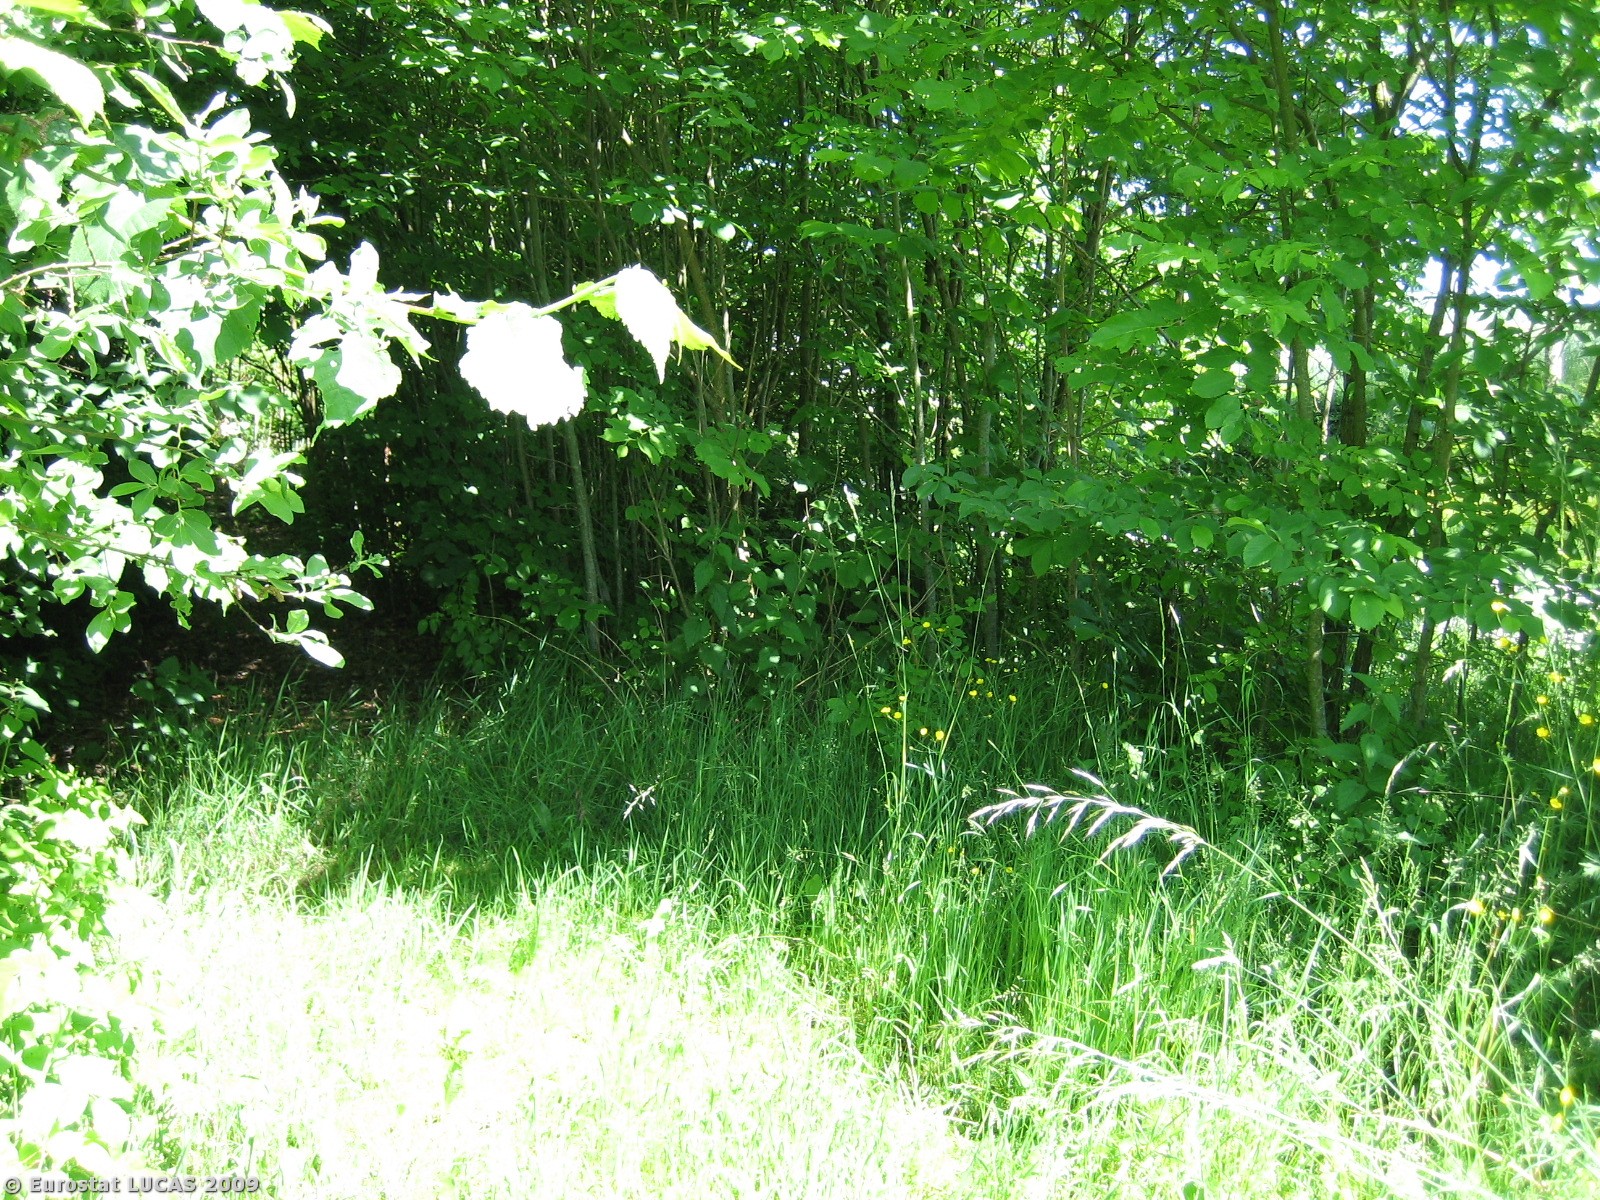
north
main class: Woodland
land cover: Broadleaved woodland
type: mesophytic deciduous forest
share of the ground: > 75 %
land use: Residential
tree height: > 5 m
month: June
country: DK
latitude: 55.9540
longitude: 9.8560
